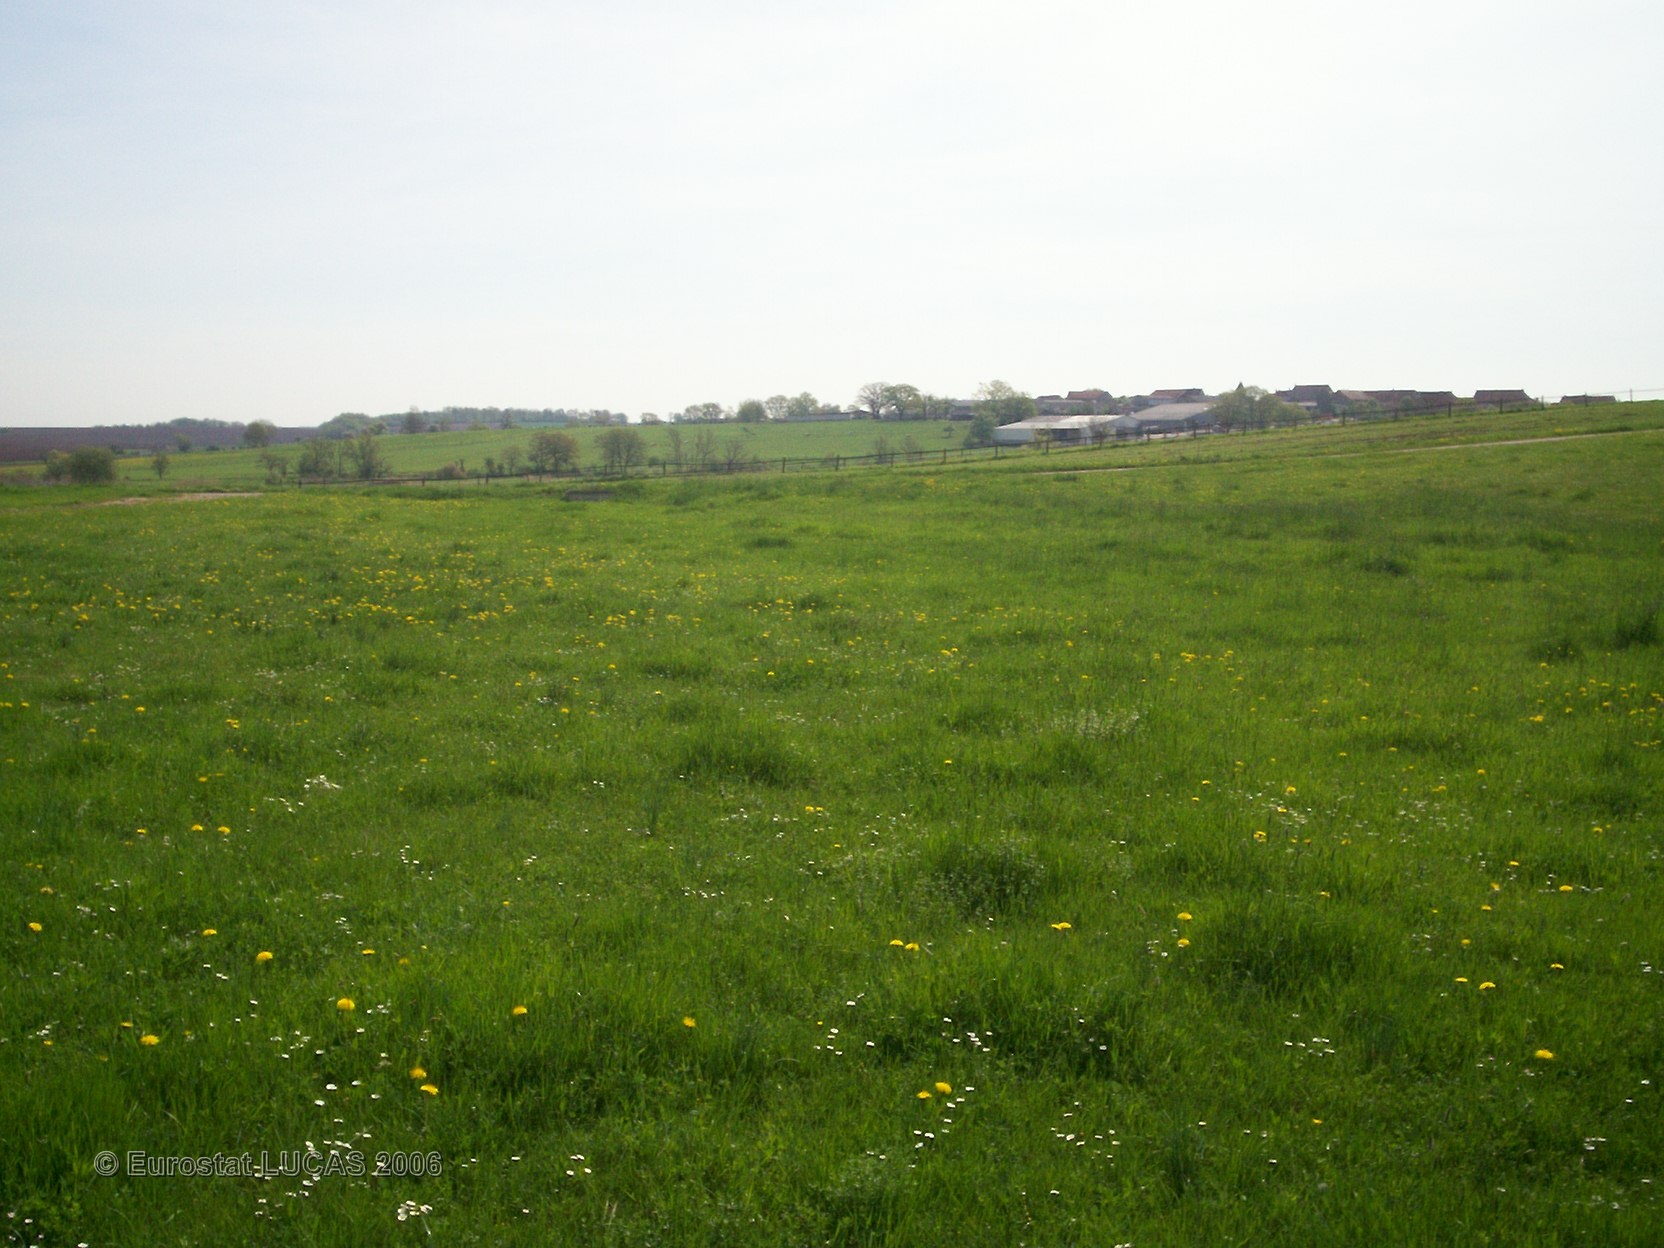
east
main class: Grassland
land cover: Grassland without tree/shrub cover
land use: Agriculture (excluding fallow land and kitchen gardens)
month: May
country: FR
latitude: 48.9565
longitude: 6.9823
